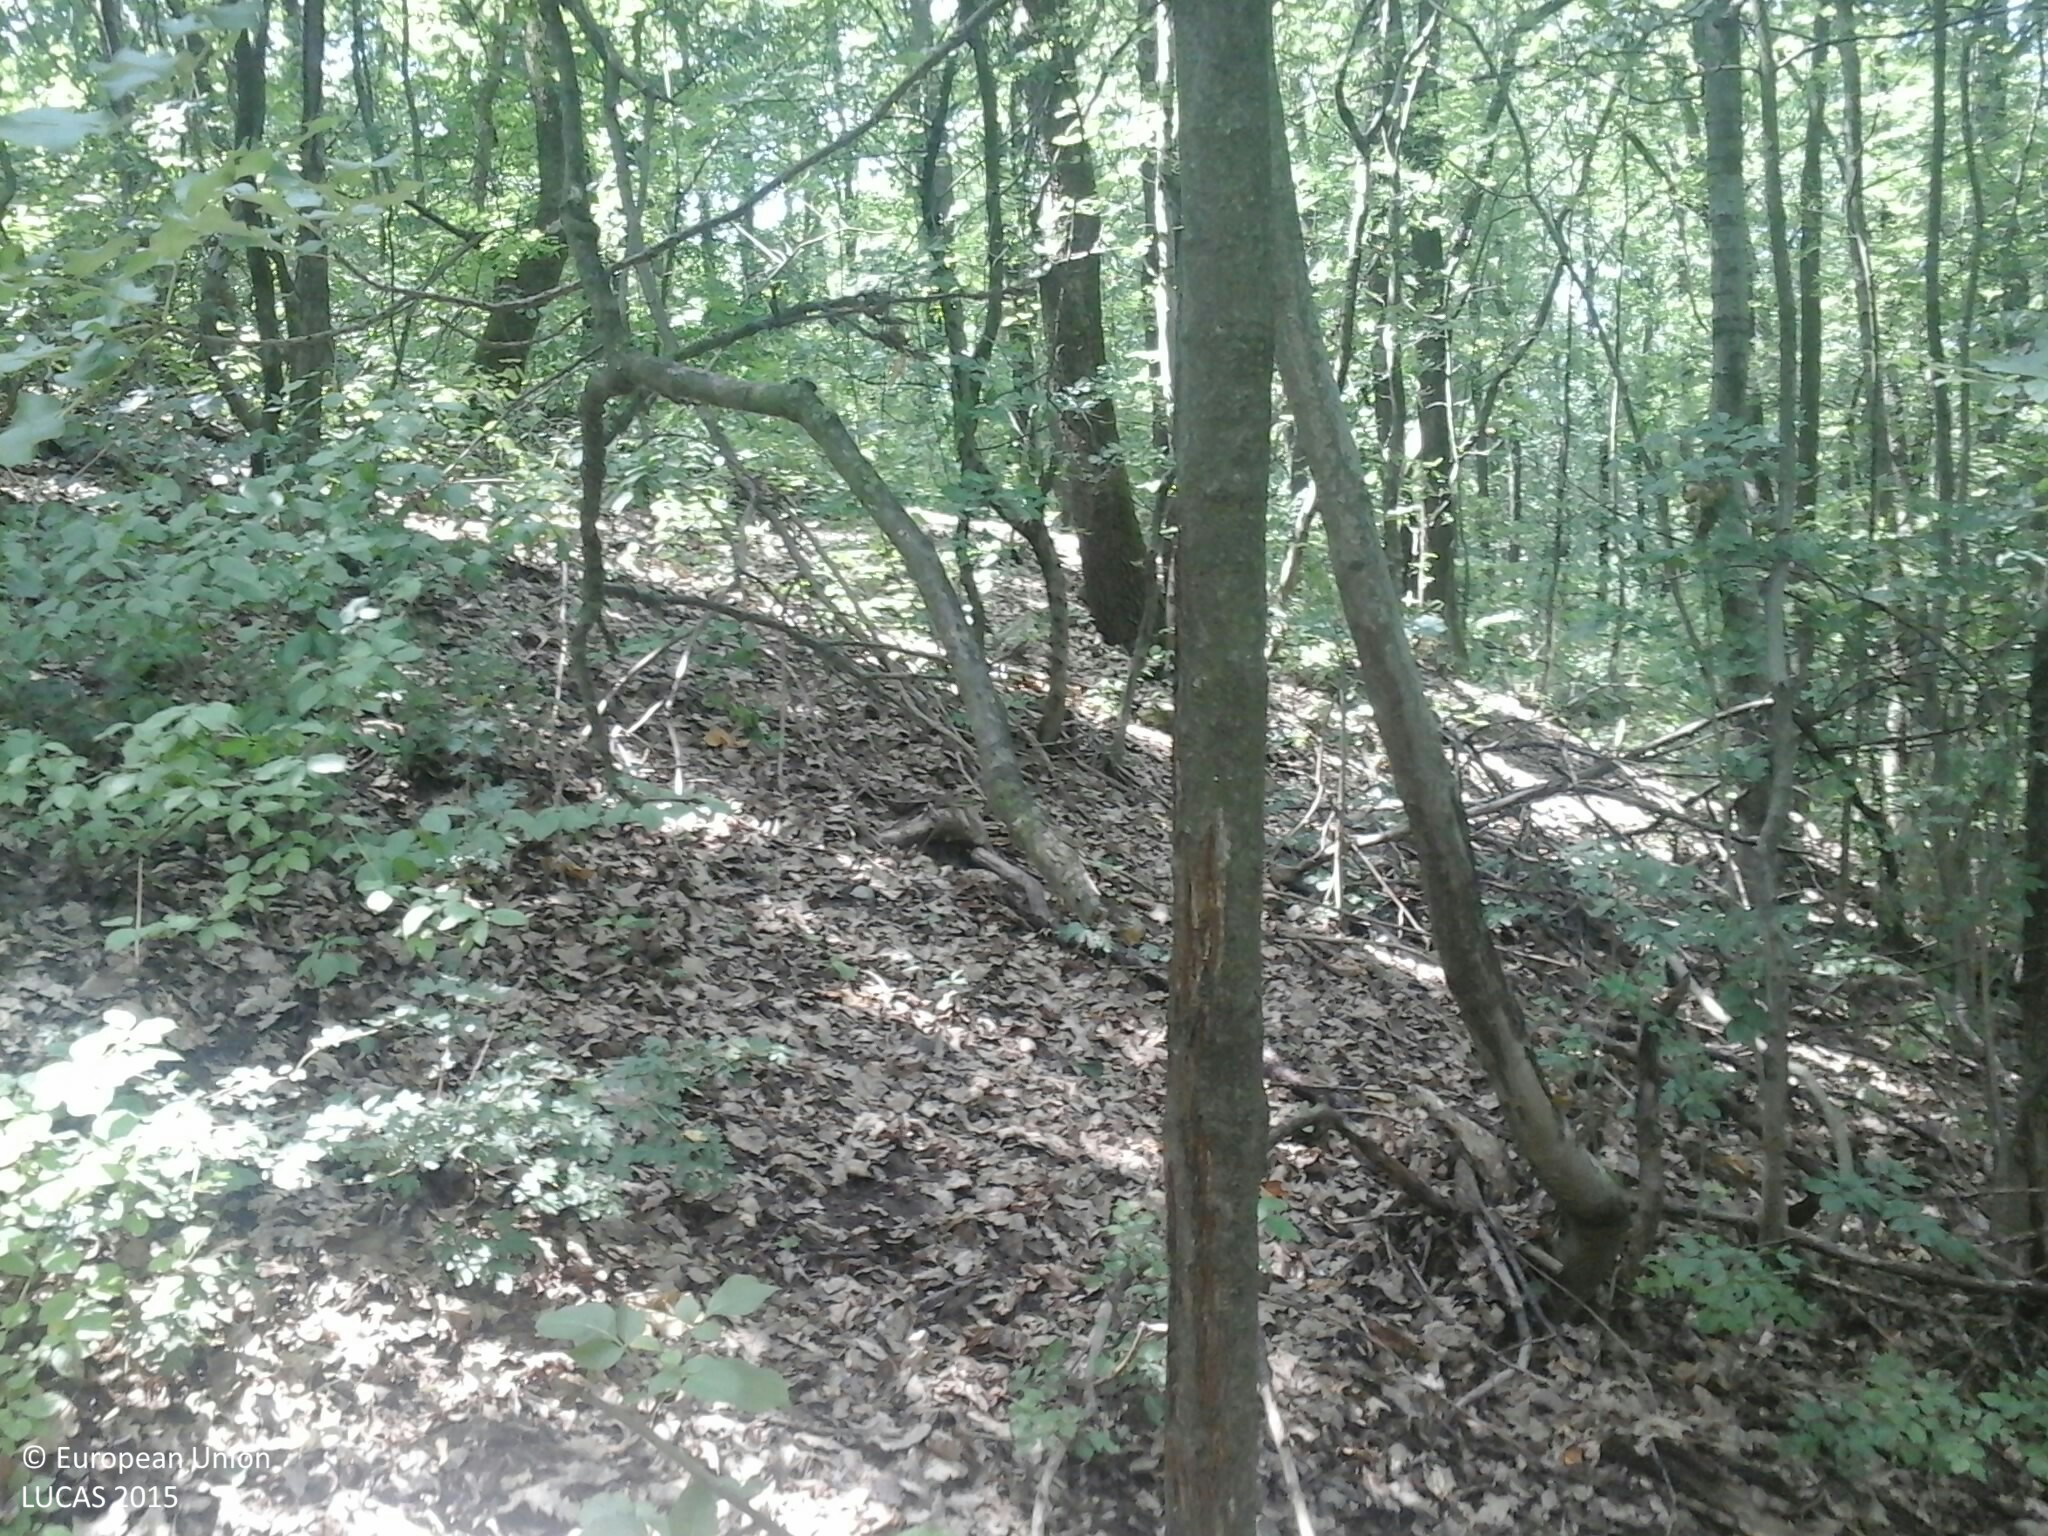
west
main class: Woodland
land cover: Broadleaved woodland
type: mesophytic deciduous forest
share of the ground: > 75 %
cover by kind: broadleaved forest trees 95 %, shrubs 5 %
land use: Forestry
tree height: < 5 m
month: July
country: HU
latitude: 47.8293
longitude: 19.0898
